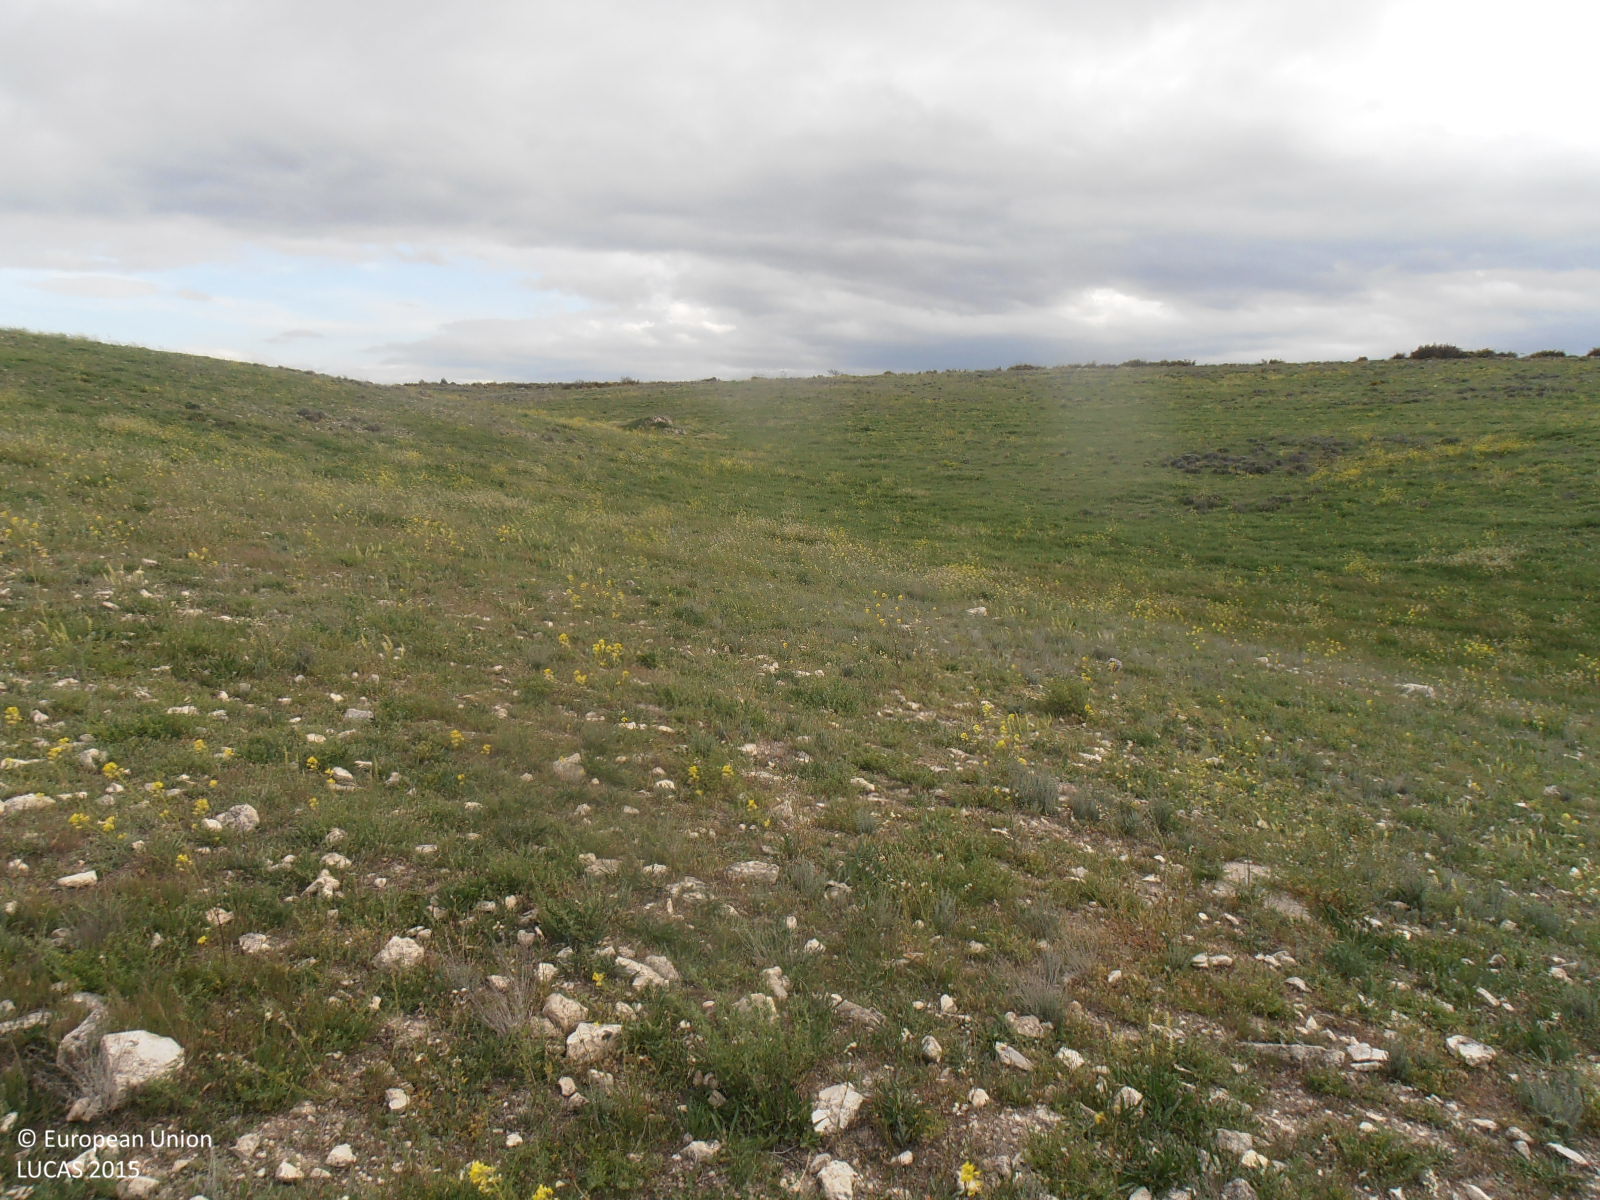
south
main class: Grassland
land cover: Spontaneously vegetated surfaces
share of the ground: > 75 %
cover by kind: herbaceous plants 85 %, unconsolidated bare surface 10 %, shrubs 5 %
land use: Abandoned areas
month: May
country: ES
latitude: 41.4421
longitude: -0.9238
